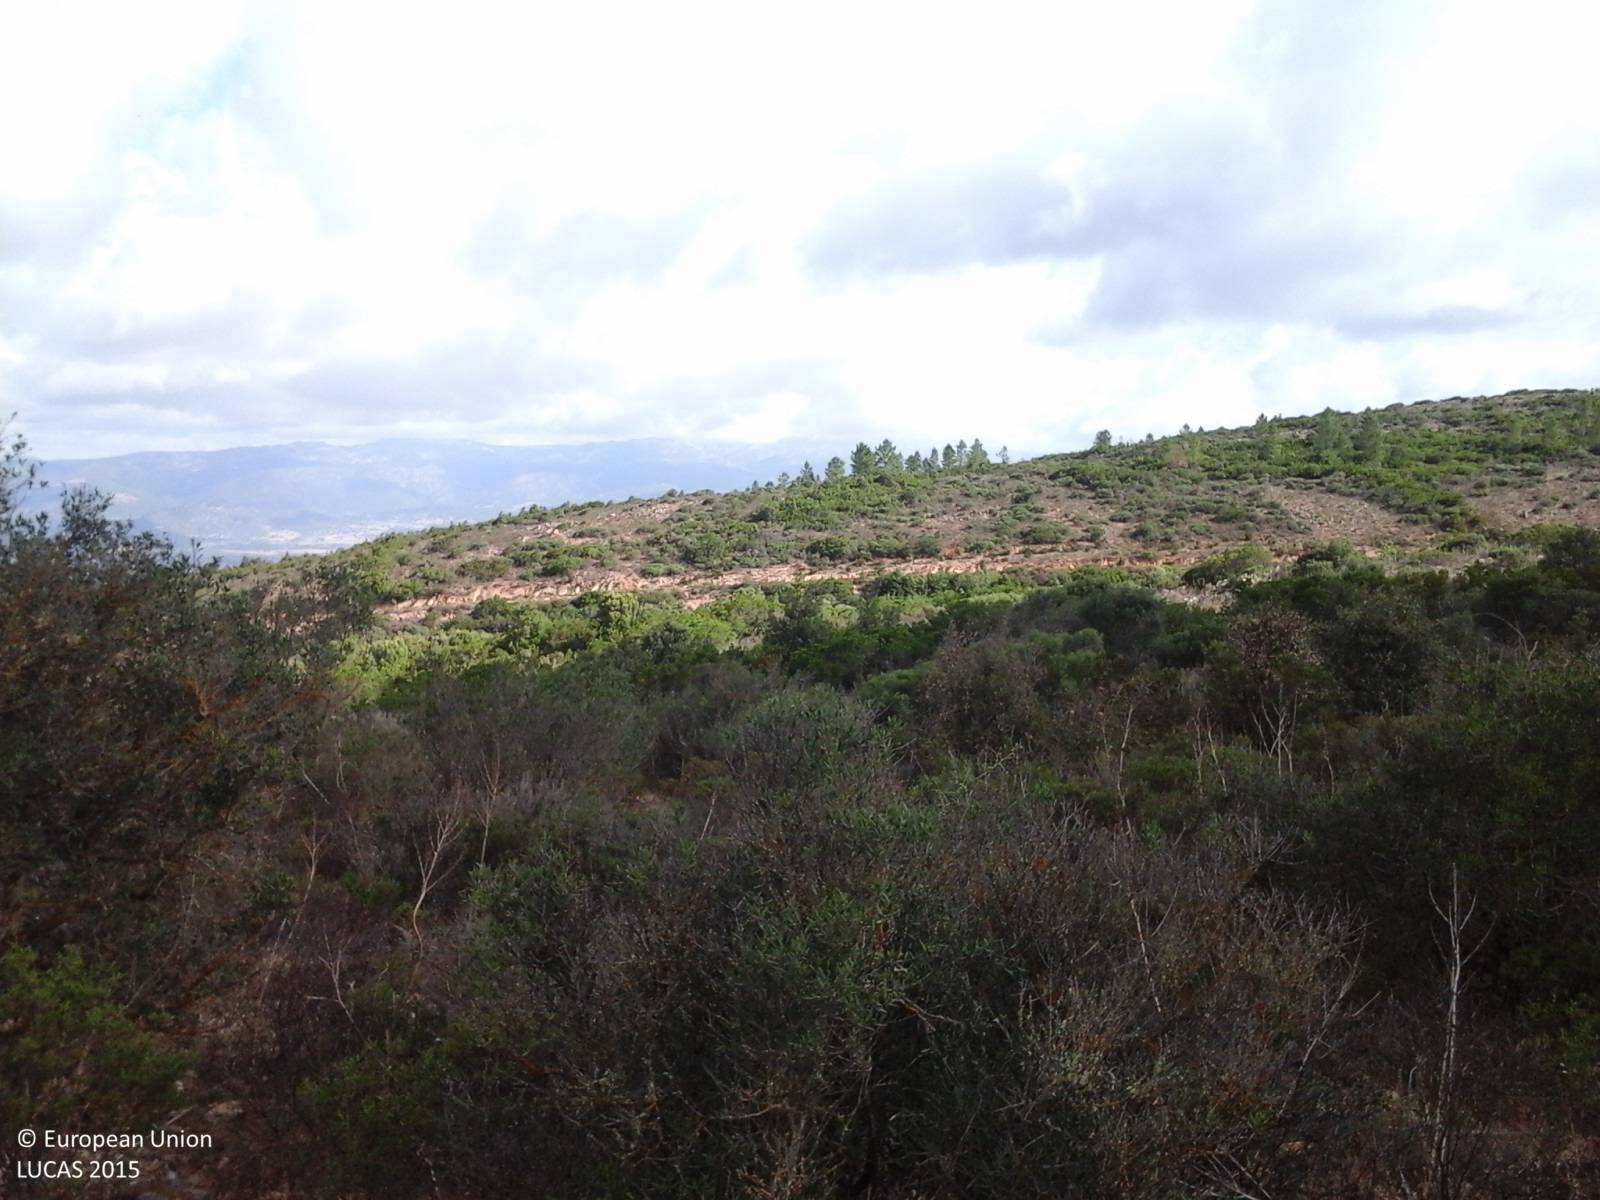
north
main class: Shrubland
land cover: Shrubland without tree cover
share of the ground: > 75 %
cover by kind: shrubs 70 %, herbaceous plants 30 %
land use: Semi-natural and natural areas not in use
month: August
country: IT
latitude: 40.6620
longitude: 9.1643
